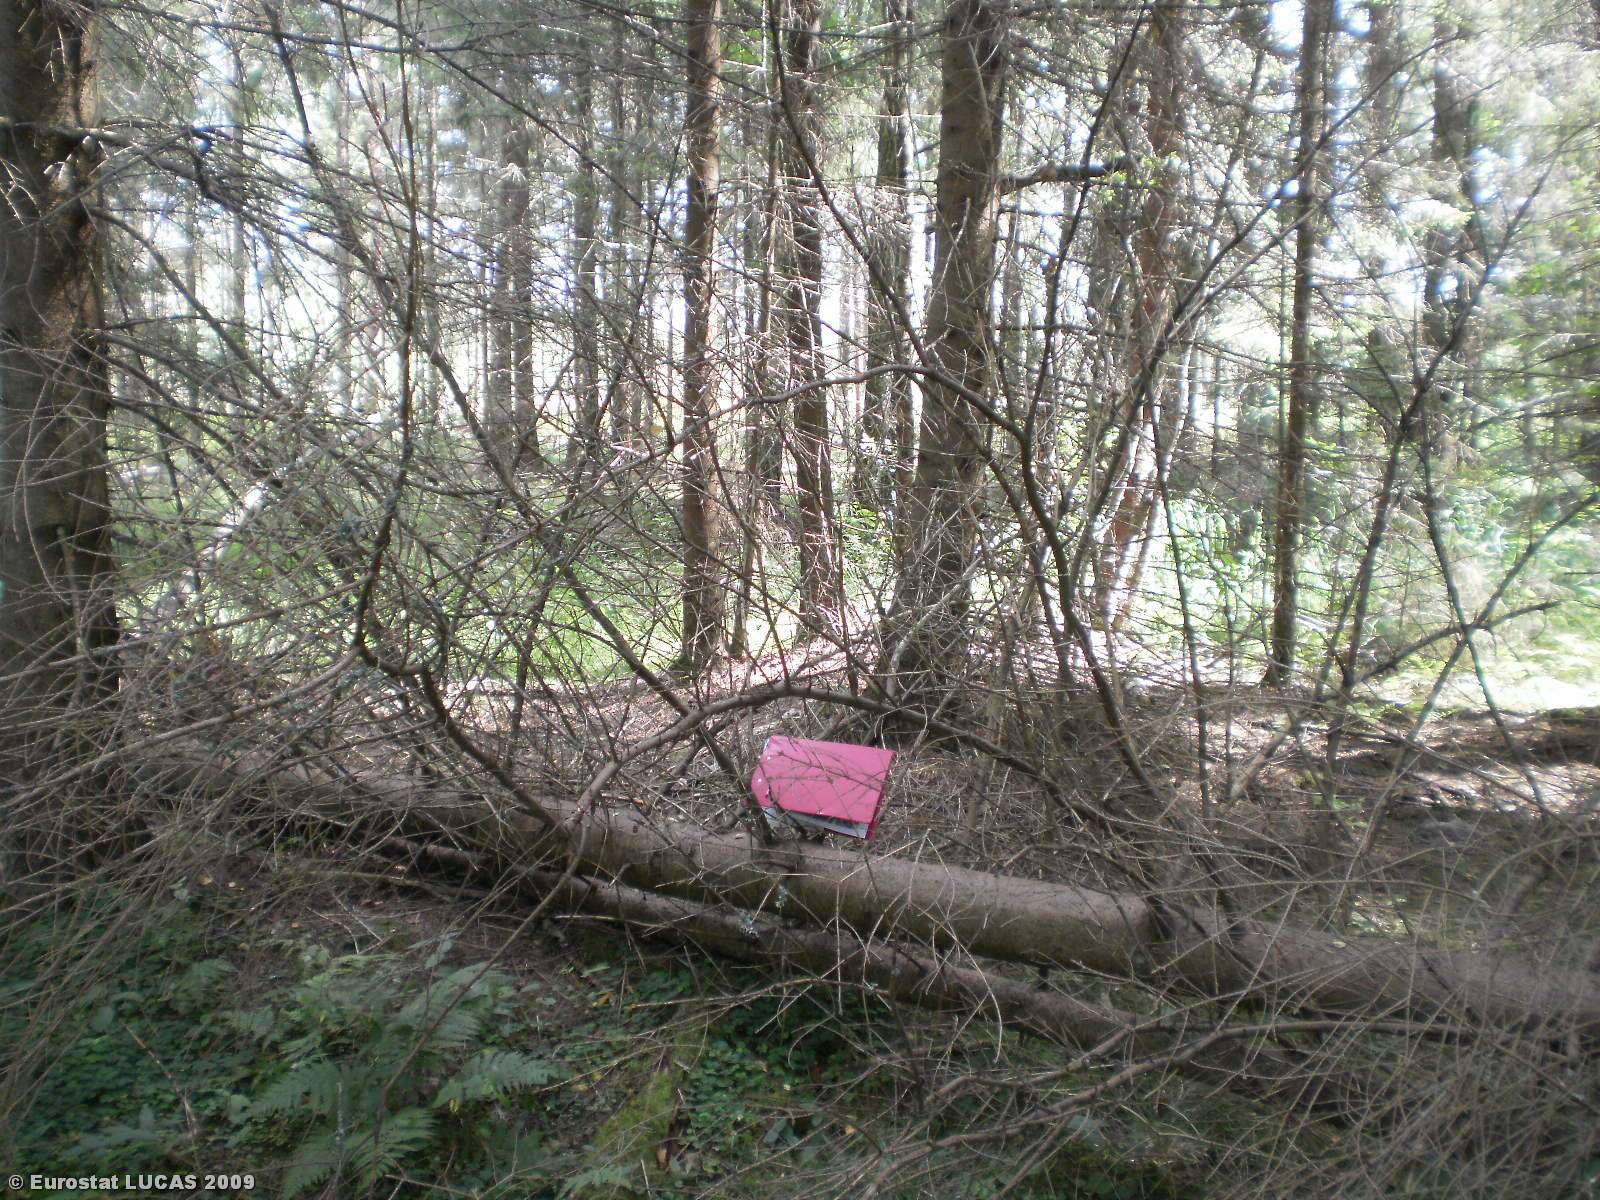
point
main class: Woodland
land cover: Coniferous woodland
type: hemiboreal forest and nemoral coniferous forest and mixed broadleaved-coniferous forest
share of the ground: > 75 %
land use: Forestry
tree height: > 5 m
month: August
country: LT
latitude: 55.5932
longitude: 25.1422
